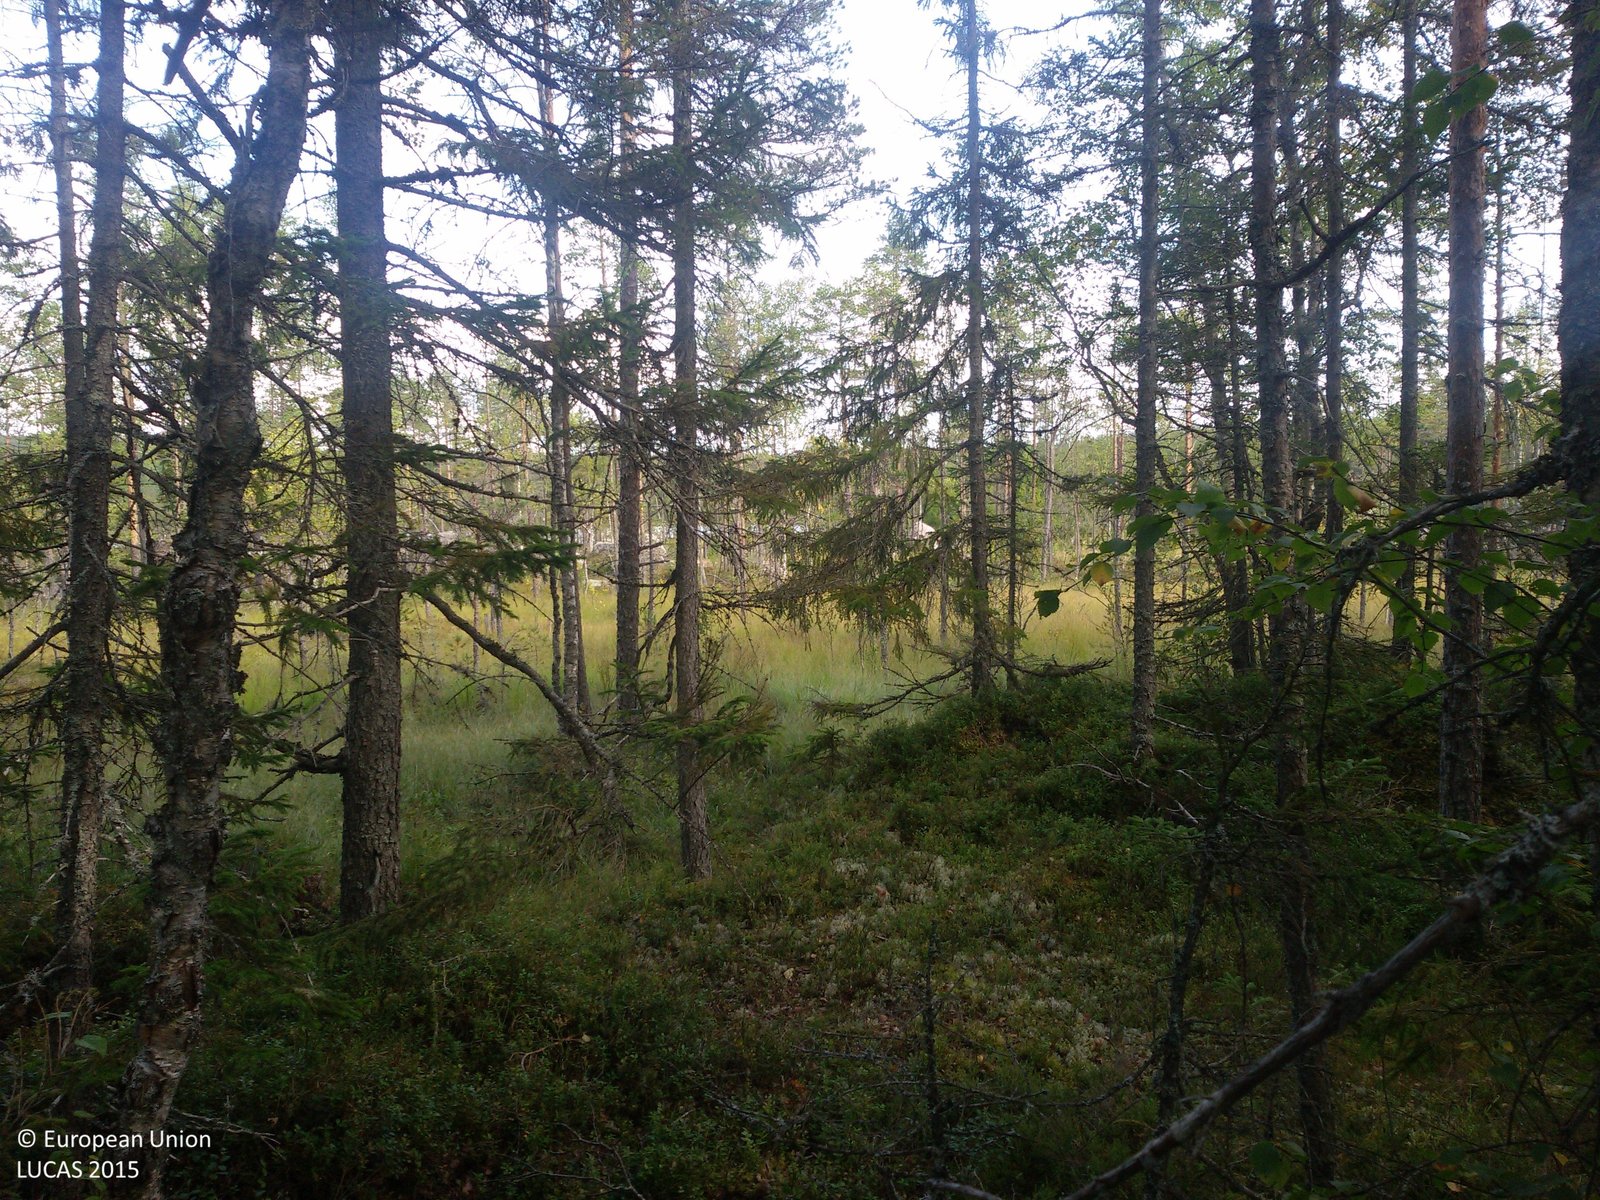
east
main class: Woodland
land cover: Pine dominated mixed woodland
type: boreal forest
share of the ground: 50 - 75 %
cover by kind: coniferous forest trees 45 %, broadleaved forest trees 25 %, herbaceous plants 15 %, lichens and mosses 15 %
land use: Forestry
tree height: > 5 m
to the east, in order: Pine dominated mixed woodland; Pine dominated coniferous woodland; Spontaneously vegetated surfaces; Pine dominated coniferous woodland; Spontaneously vegetated surfaces; Inland fresh water bodies; Spontaneously vegetated surfaces
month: September
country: SE
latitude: 60.8695
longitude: 15.4557
